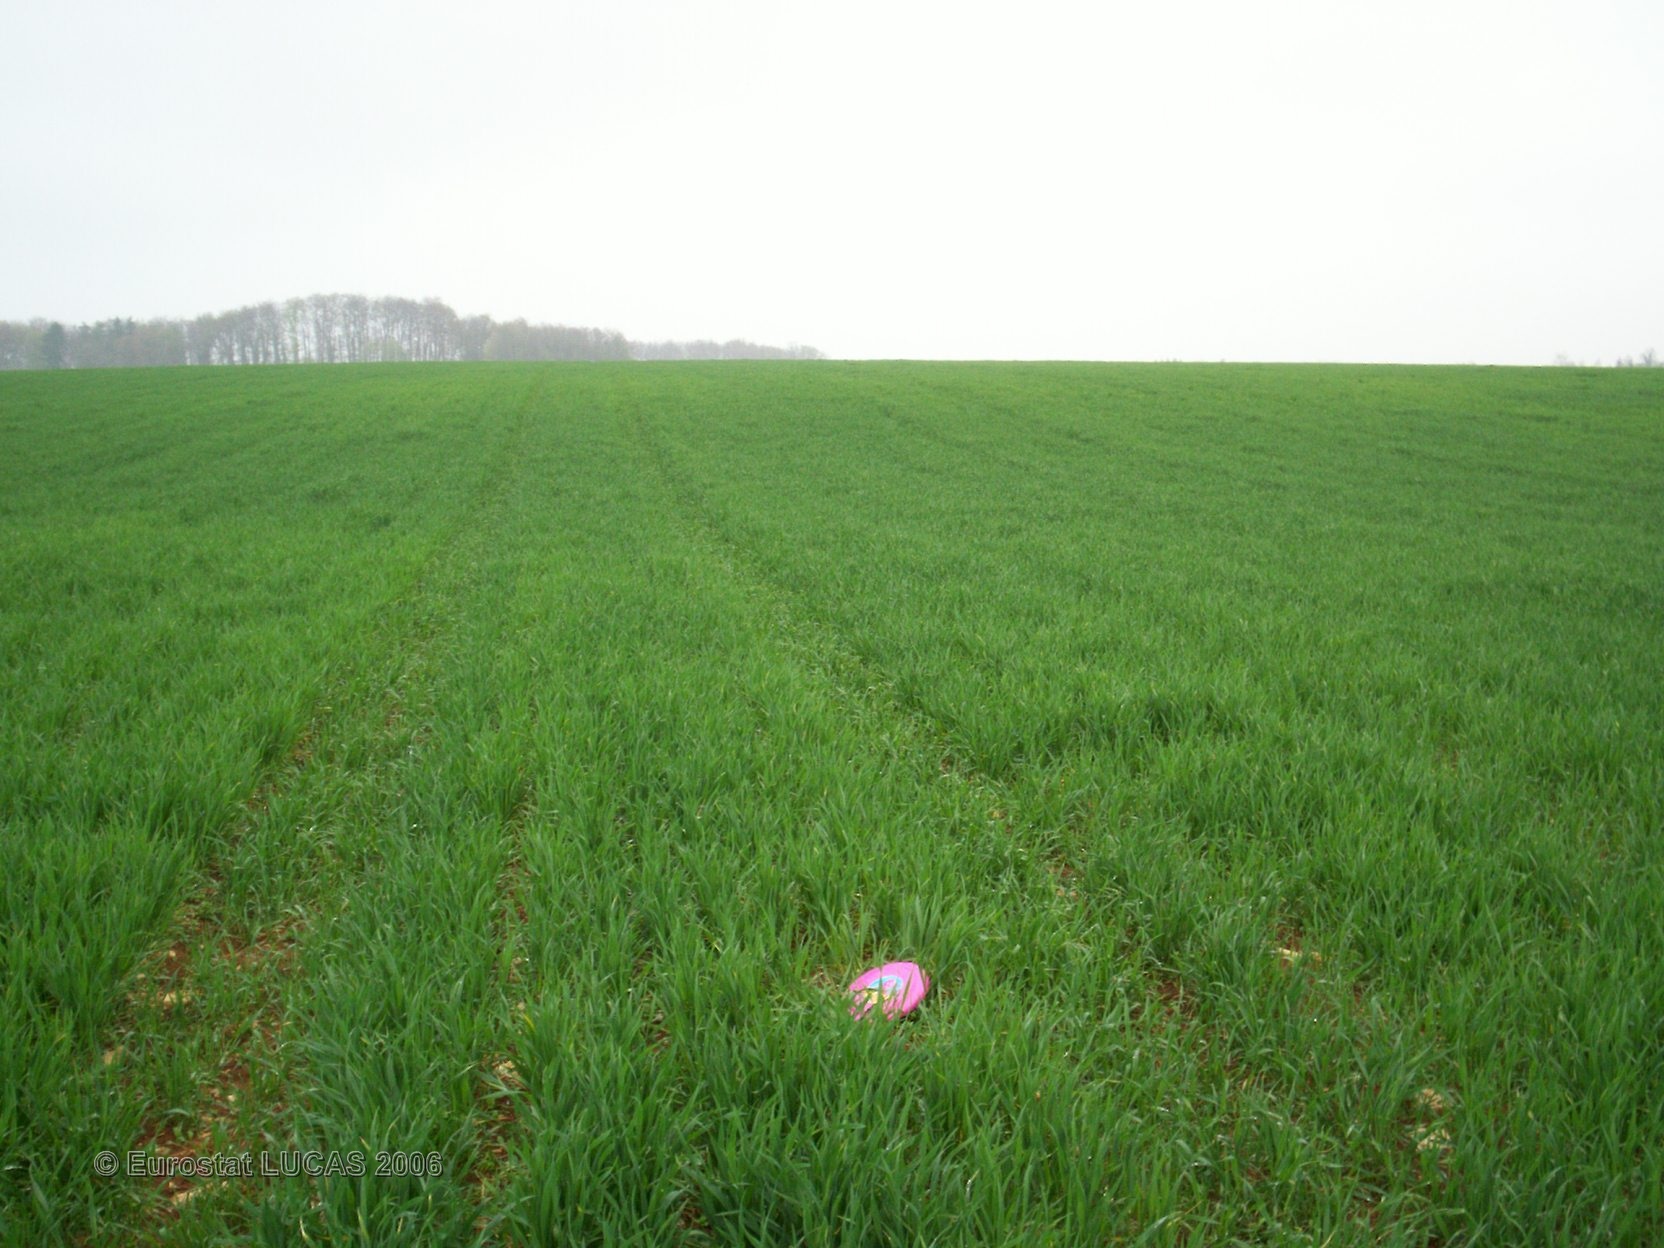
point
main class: Cropland
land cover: Common wheat
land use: Agriculture (excluding fallow land and kitchen gardens)
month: April
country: FR
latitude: 47.7803
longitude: 4.5132
